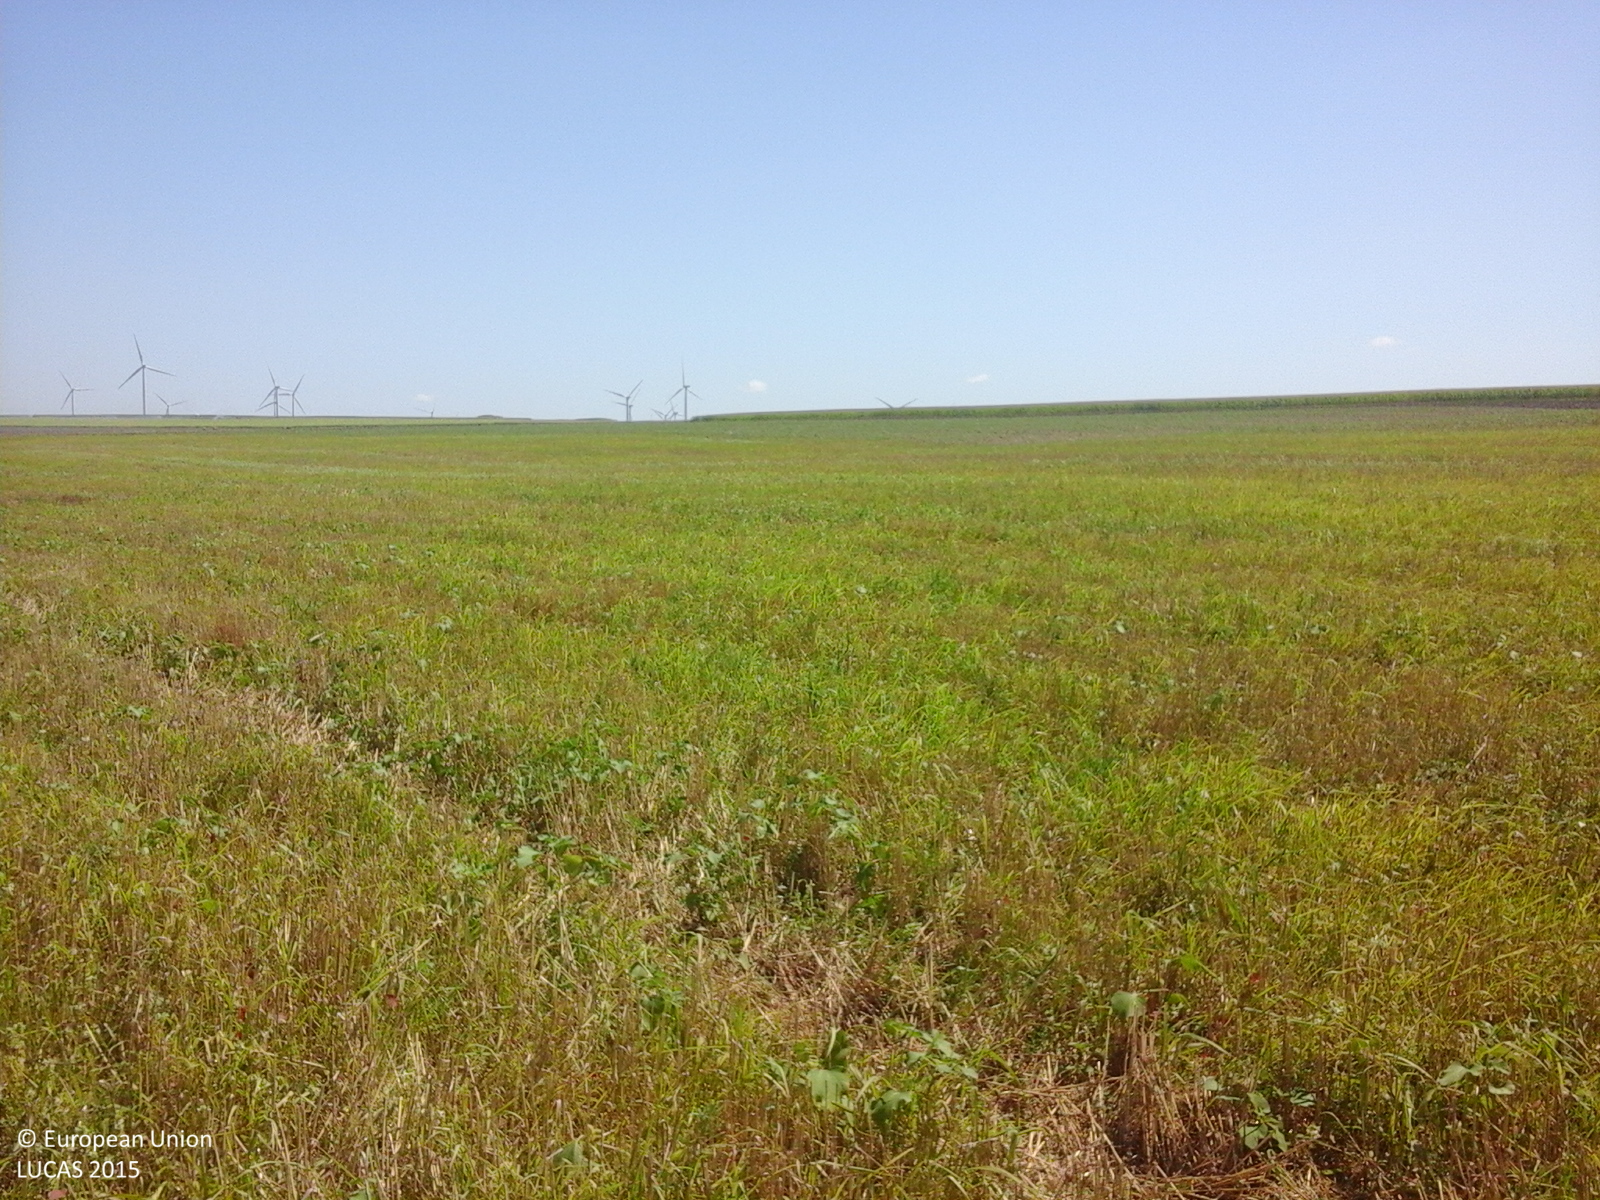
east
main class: Cropland
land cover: Common wheat
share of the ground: > 75 %
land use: Agriculture (excluding fallow land and kitchen gardens)
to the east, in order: Common wheat; Rape and turnip rape
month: August
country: RO
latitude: 44.6285
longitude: 28.4896
